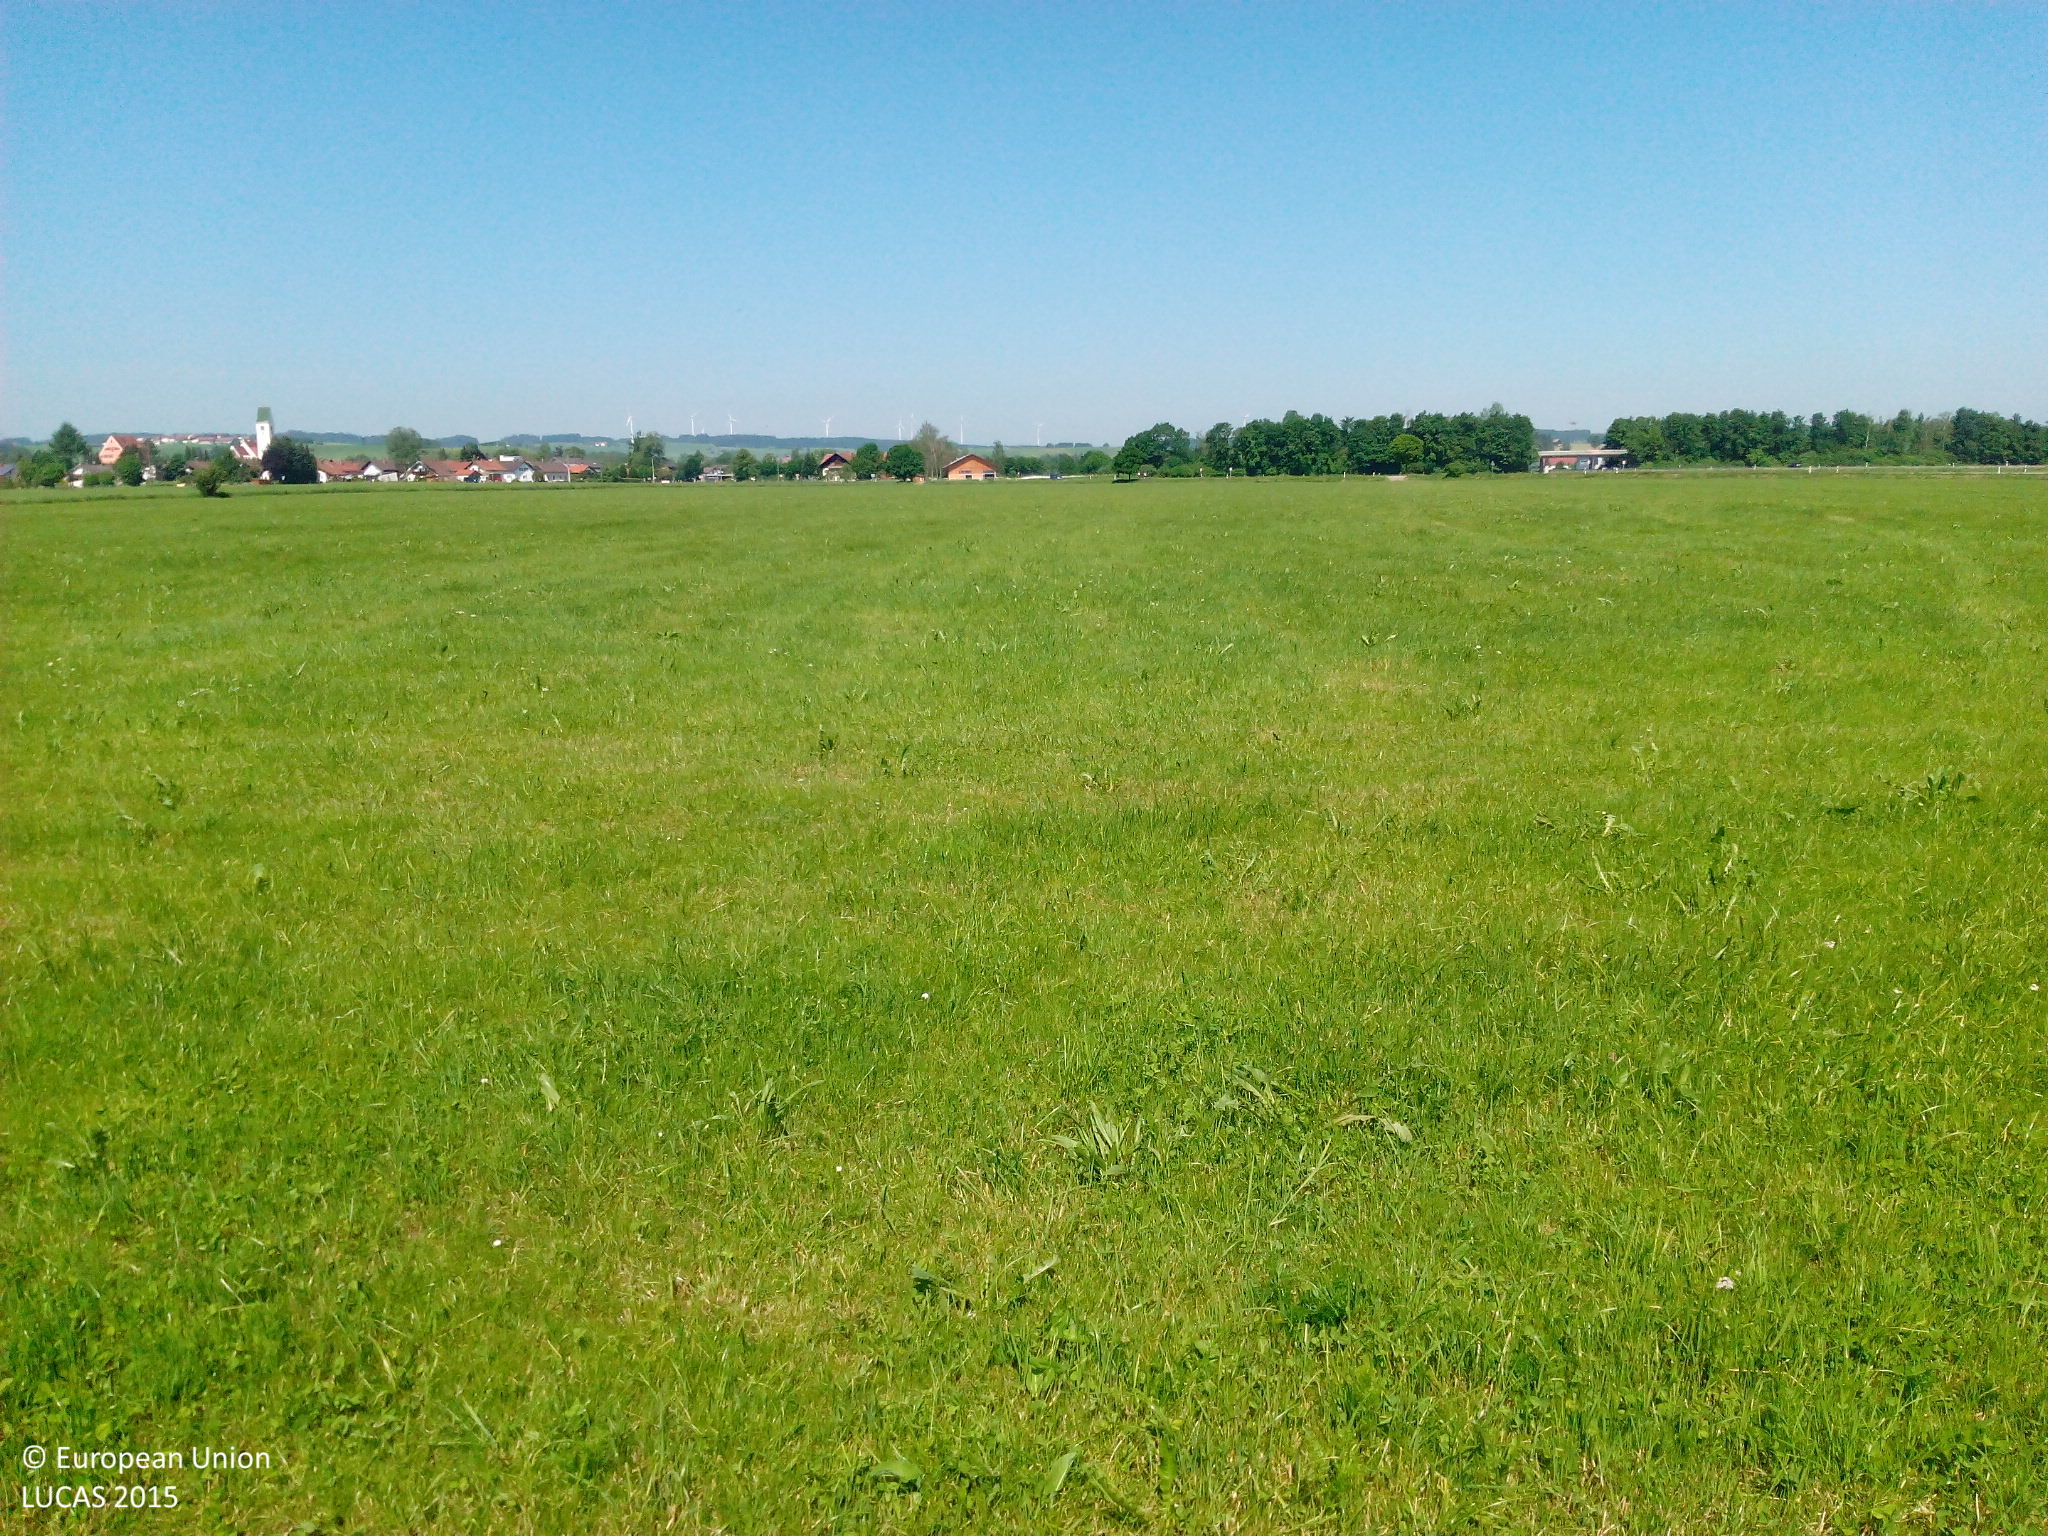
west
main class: Grassland
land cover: Grassland without tree/shrub cover
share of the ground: > 75 %
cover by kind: herbaceous plants 100 %
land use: Agriculture (excluding fallow land and kitchen gardens)
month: June
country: DE
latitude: 47.7724
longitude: 10.5200
